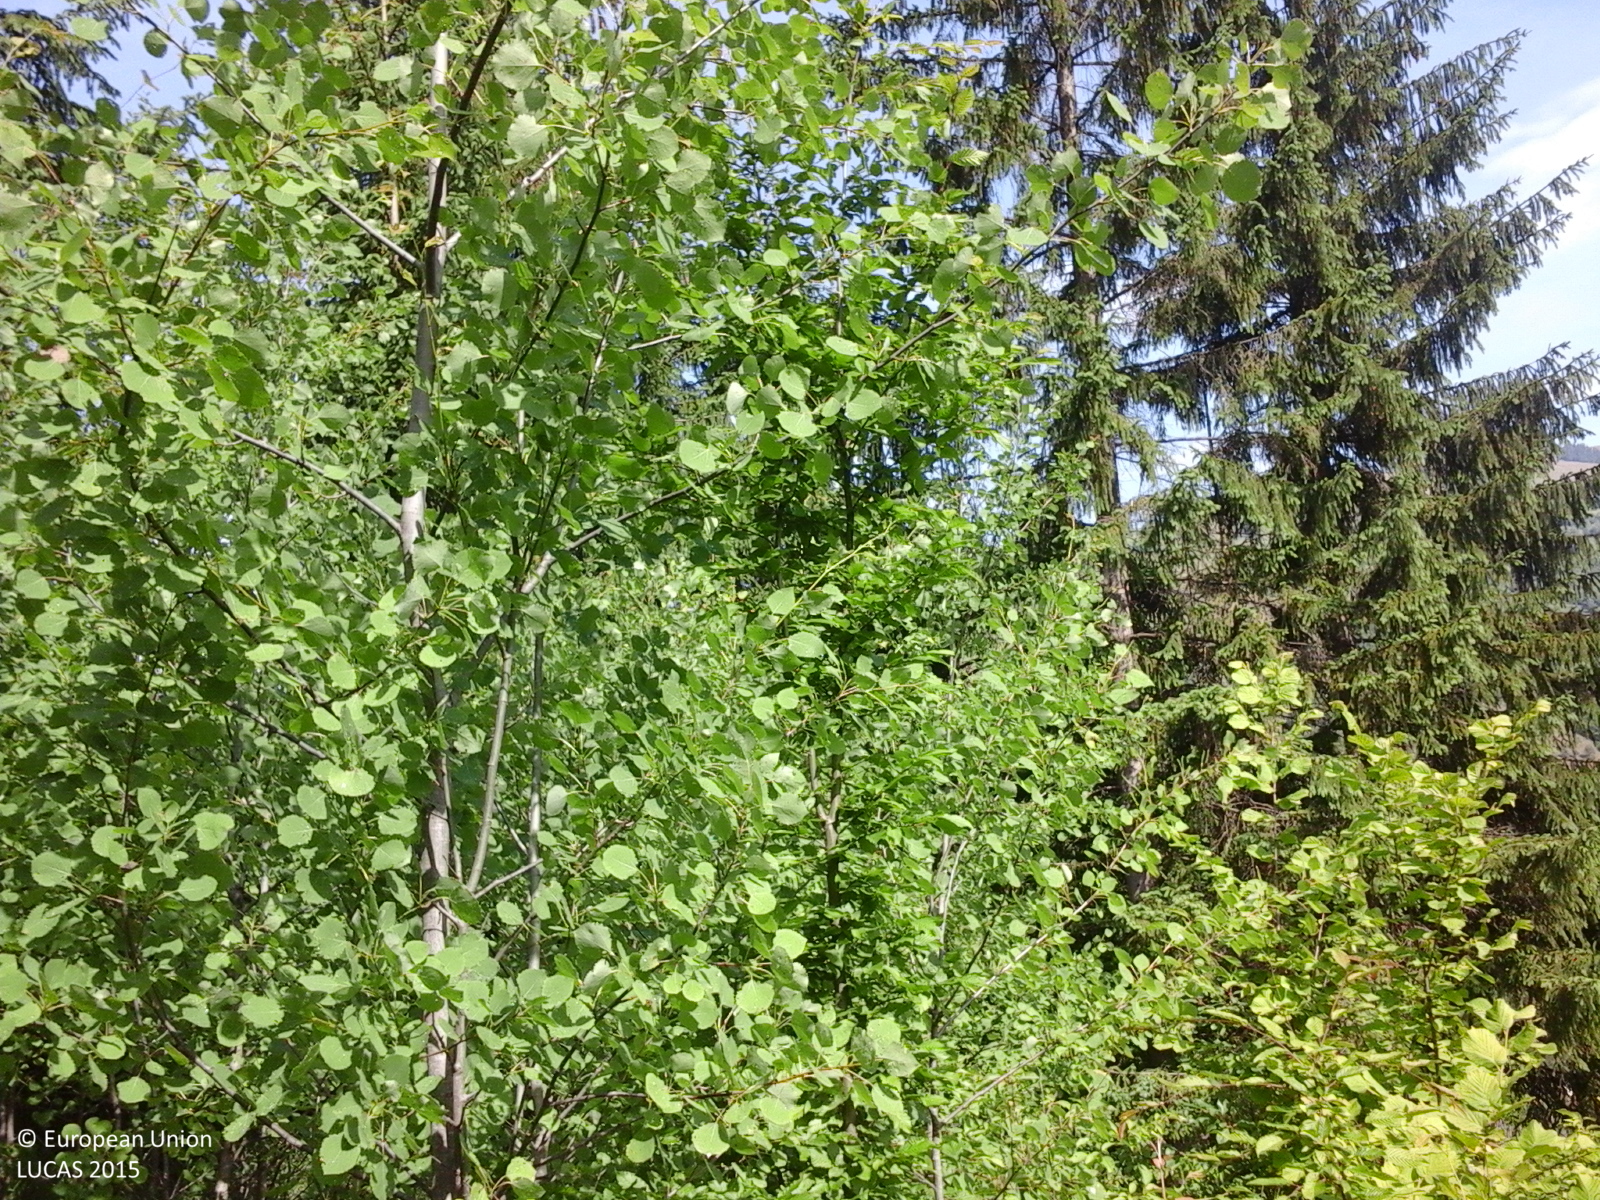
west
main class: Woodland
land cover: Spruce dominated coniferous woodland
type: alpine coniferous forest
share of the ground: > 75 %
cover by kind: coniferous forest trees 75 %, herbaceous plants 15 %, broadleaved forest trees 5 %, shrubs 5 %
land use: Forestry
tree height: > 5 m
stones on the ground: < 10 %
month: June
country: RO
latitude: 46.8678
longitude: 25.9573
